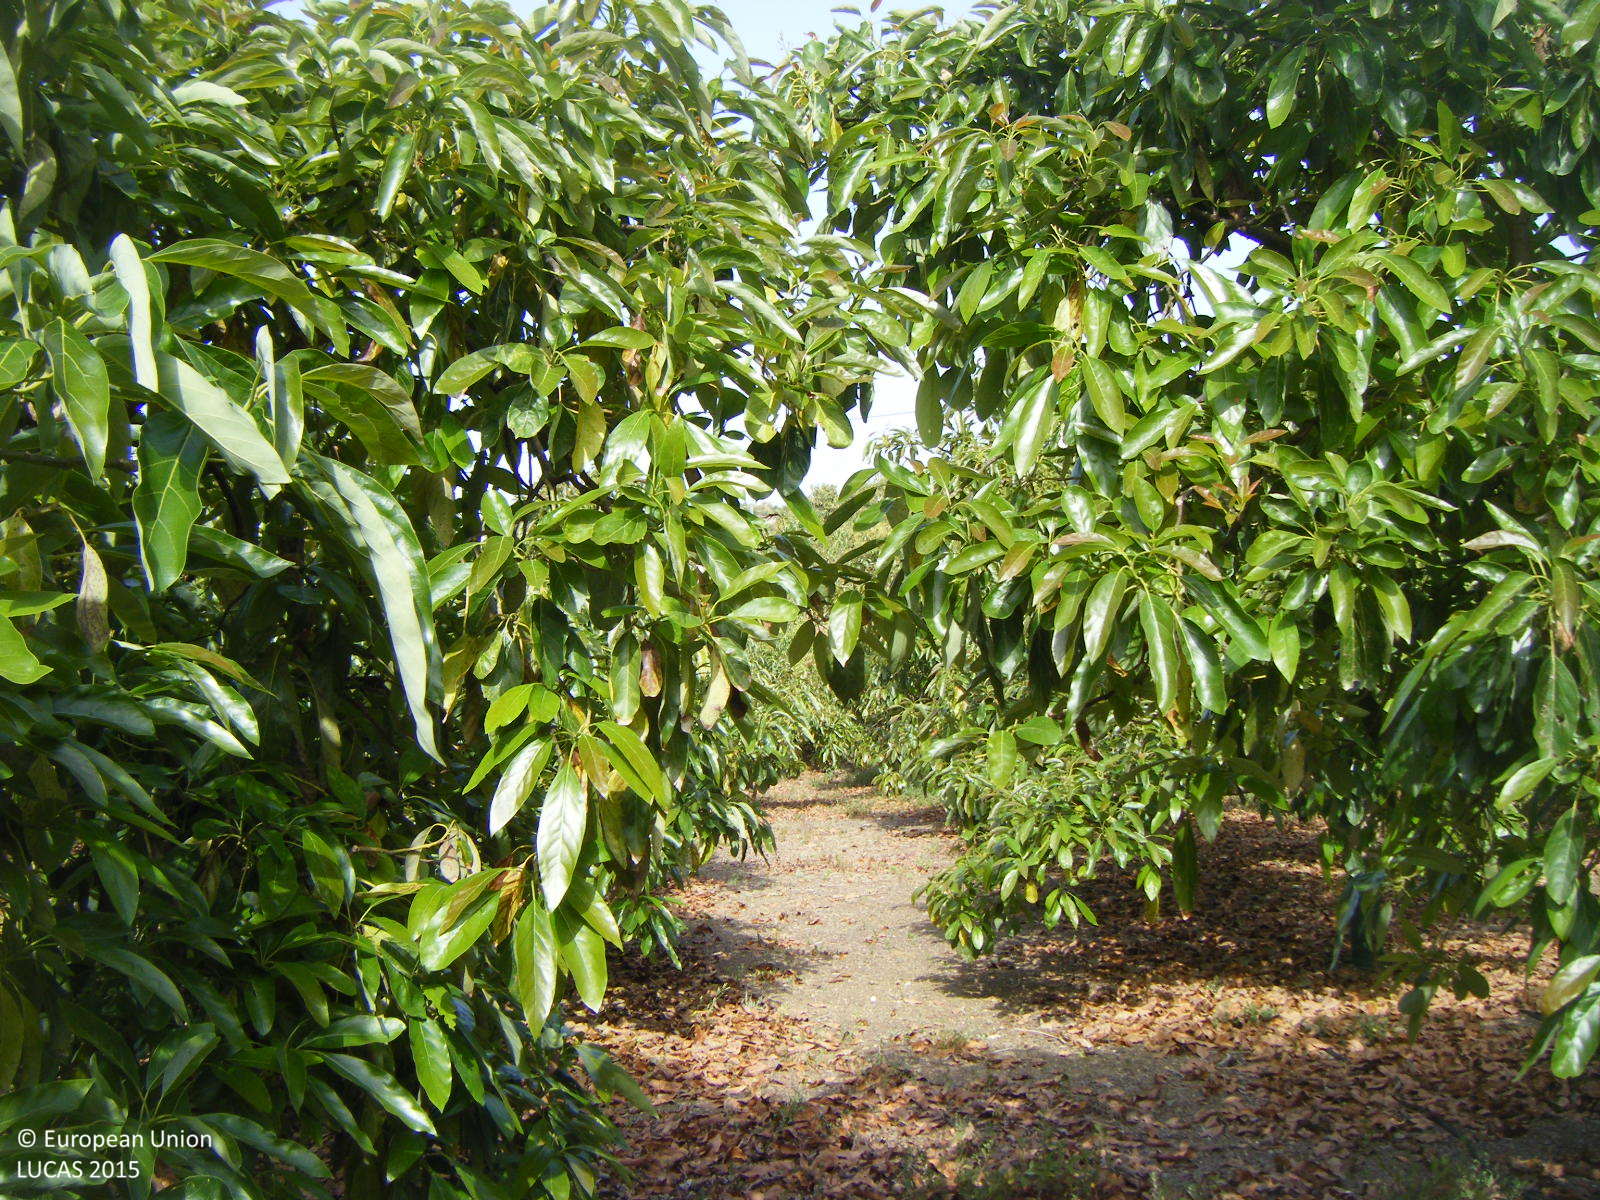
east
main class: Cropland
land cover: Other fruit trees and berries
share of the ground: 50 - 75 %
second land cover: Other bare soil
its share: > 75 %
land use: Agriculture (excluding fallow land and kitchen gardens)
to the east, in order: Other fruit trees and berries; Other bare soil; Tracks; Other fruit trees and berries; Tracks; Other fruit trees and berries; Arable land (only in case pi); Tracks; Shrubland without tree cover; Artificial constructions in urban areas; Tracks; Other fruit trees and berries
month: May
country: ES
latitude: 36.7694
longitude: -4.0695
